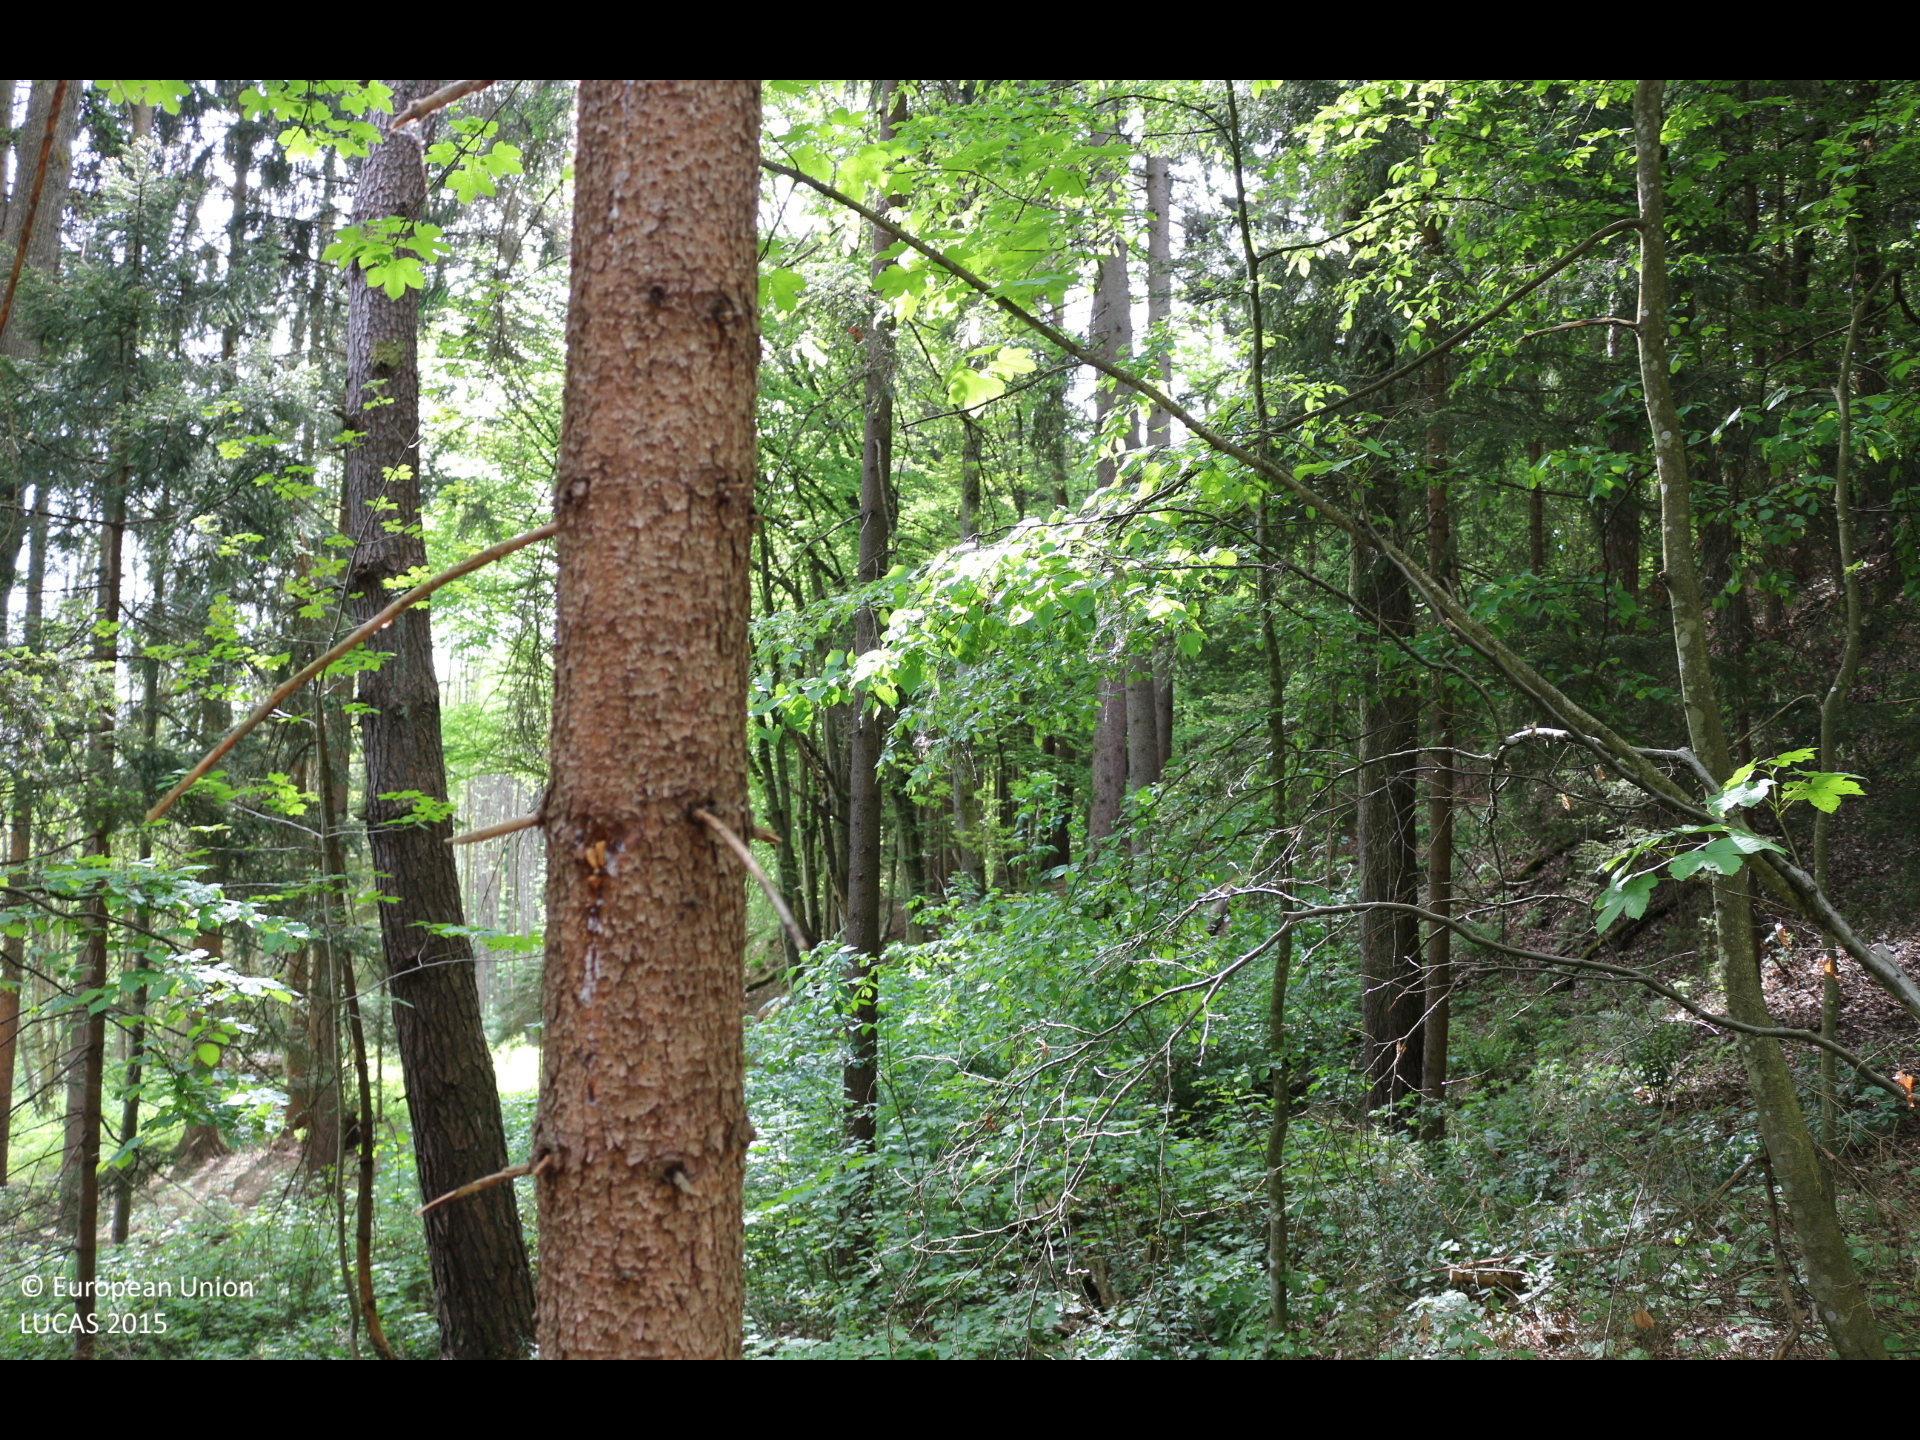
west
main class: Woodland
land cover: Spruce dominated mixed woodland
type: alpine coniferous forest
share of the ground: > 75 %
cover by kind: broadleaved forest trees 60 %, coniferous forest trees 40 %
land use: Forestry
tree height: > 5 m
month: May
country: AT
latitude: 46.6807
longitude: 14.2726
